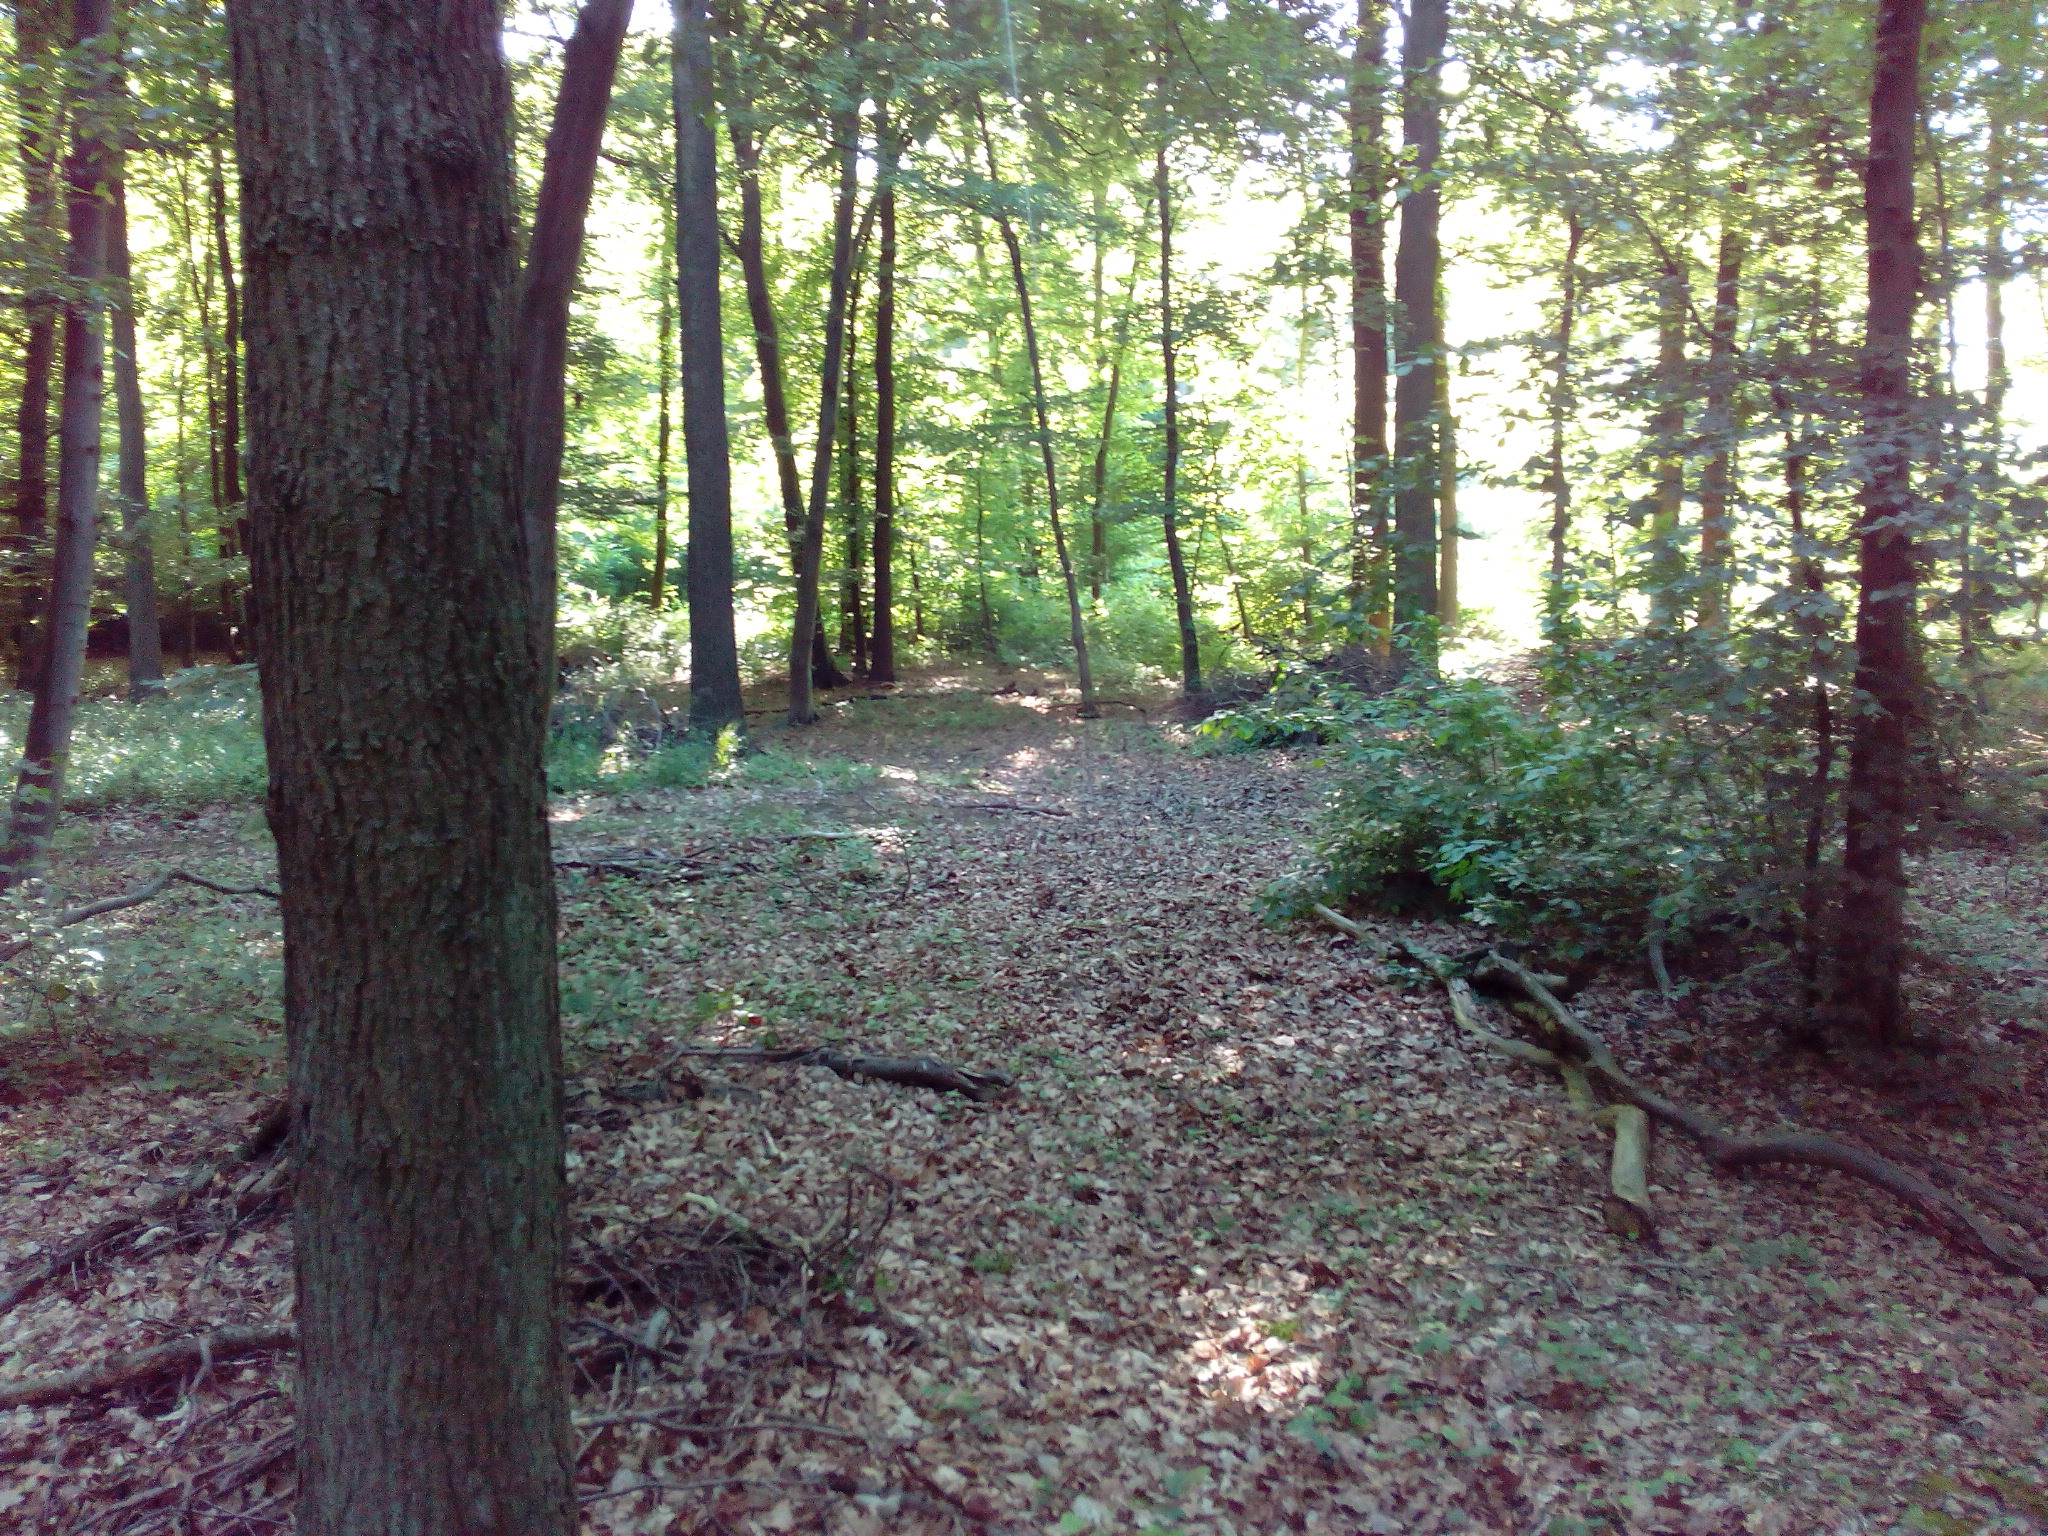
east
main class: Woodland
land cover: Broadleaved woodland
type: hemiboreal forest and nemoral coniferous forest and mixed broadleaved-coniferous forest
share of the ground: > 75 %
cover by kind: broadleaved forest trees 90 %, shrubs 5 %, herbaceous plants 5 %
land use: Forestry
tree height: > 5 m
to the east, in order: Broadleaved woodland; Fences; Broadleaved woodland; Fences; Broadleaved woodland; Tracks; Broadleaved woodland; Shrubland with sparse tree cover; Electric lines; Shrubland with sparse tree cover
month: June
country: DE
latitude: 52.3055
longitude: 9.8974
